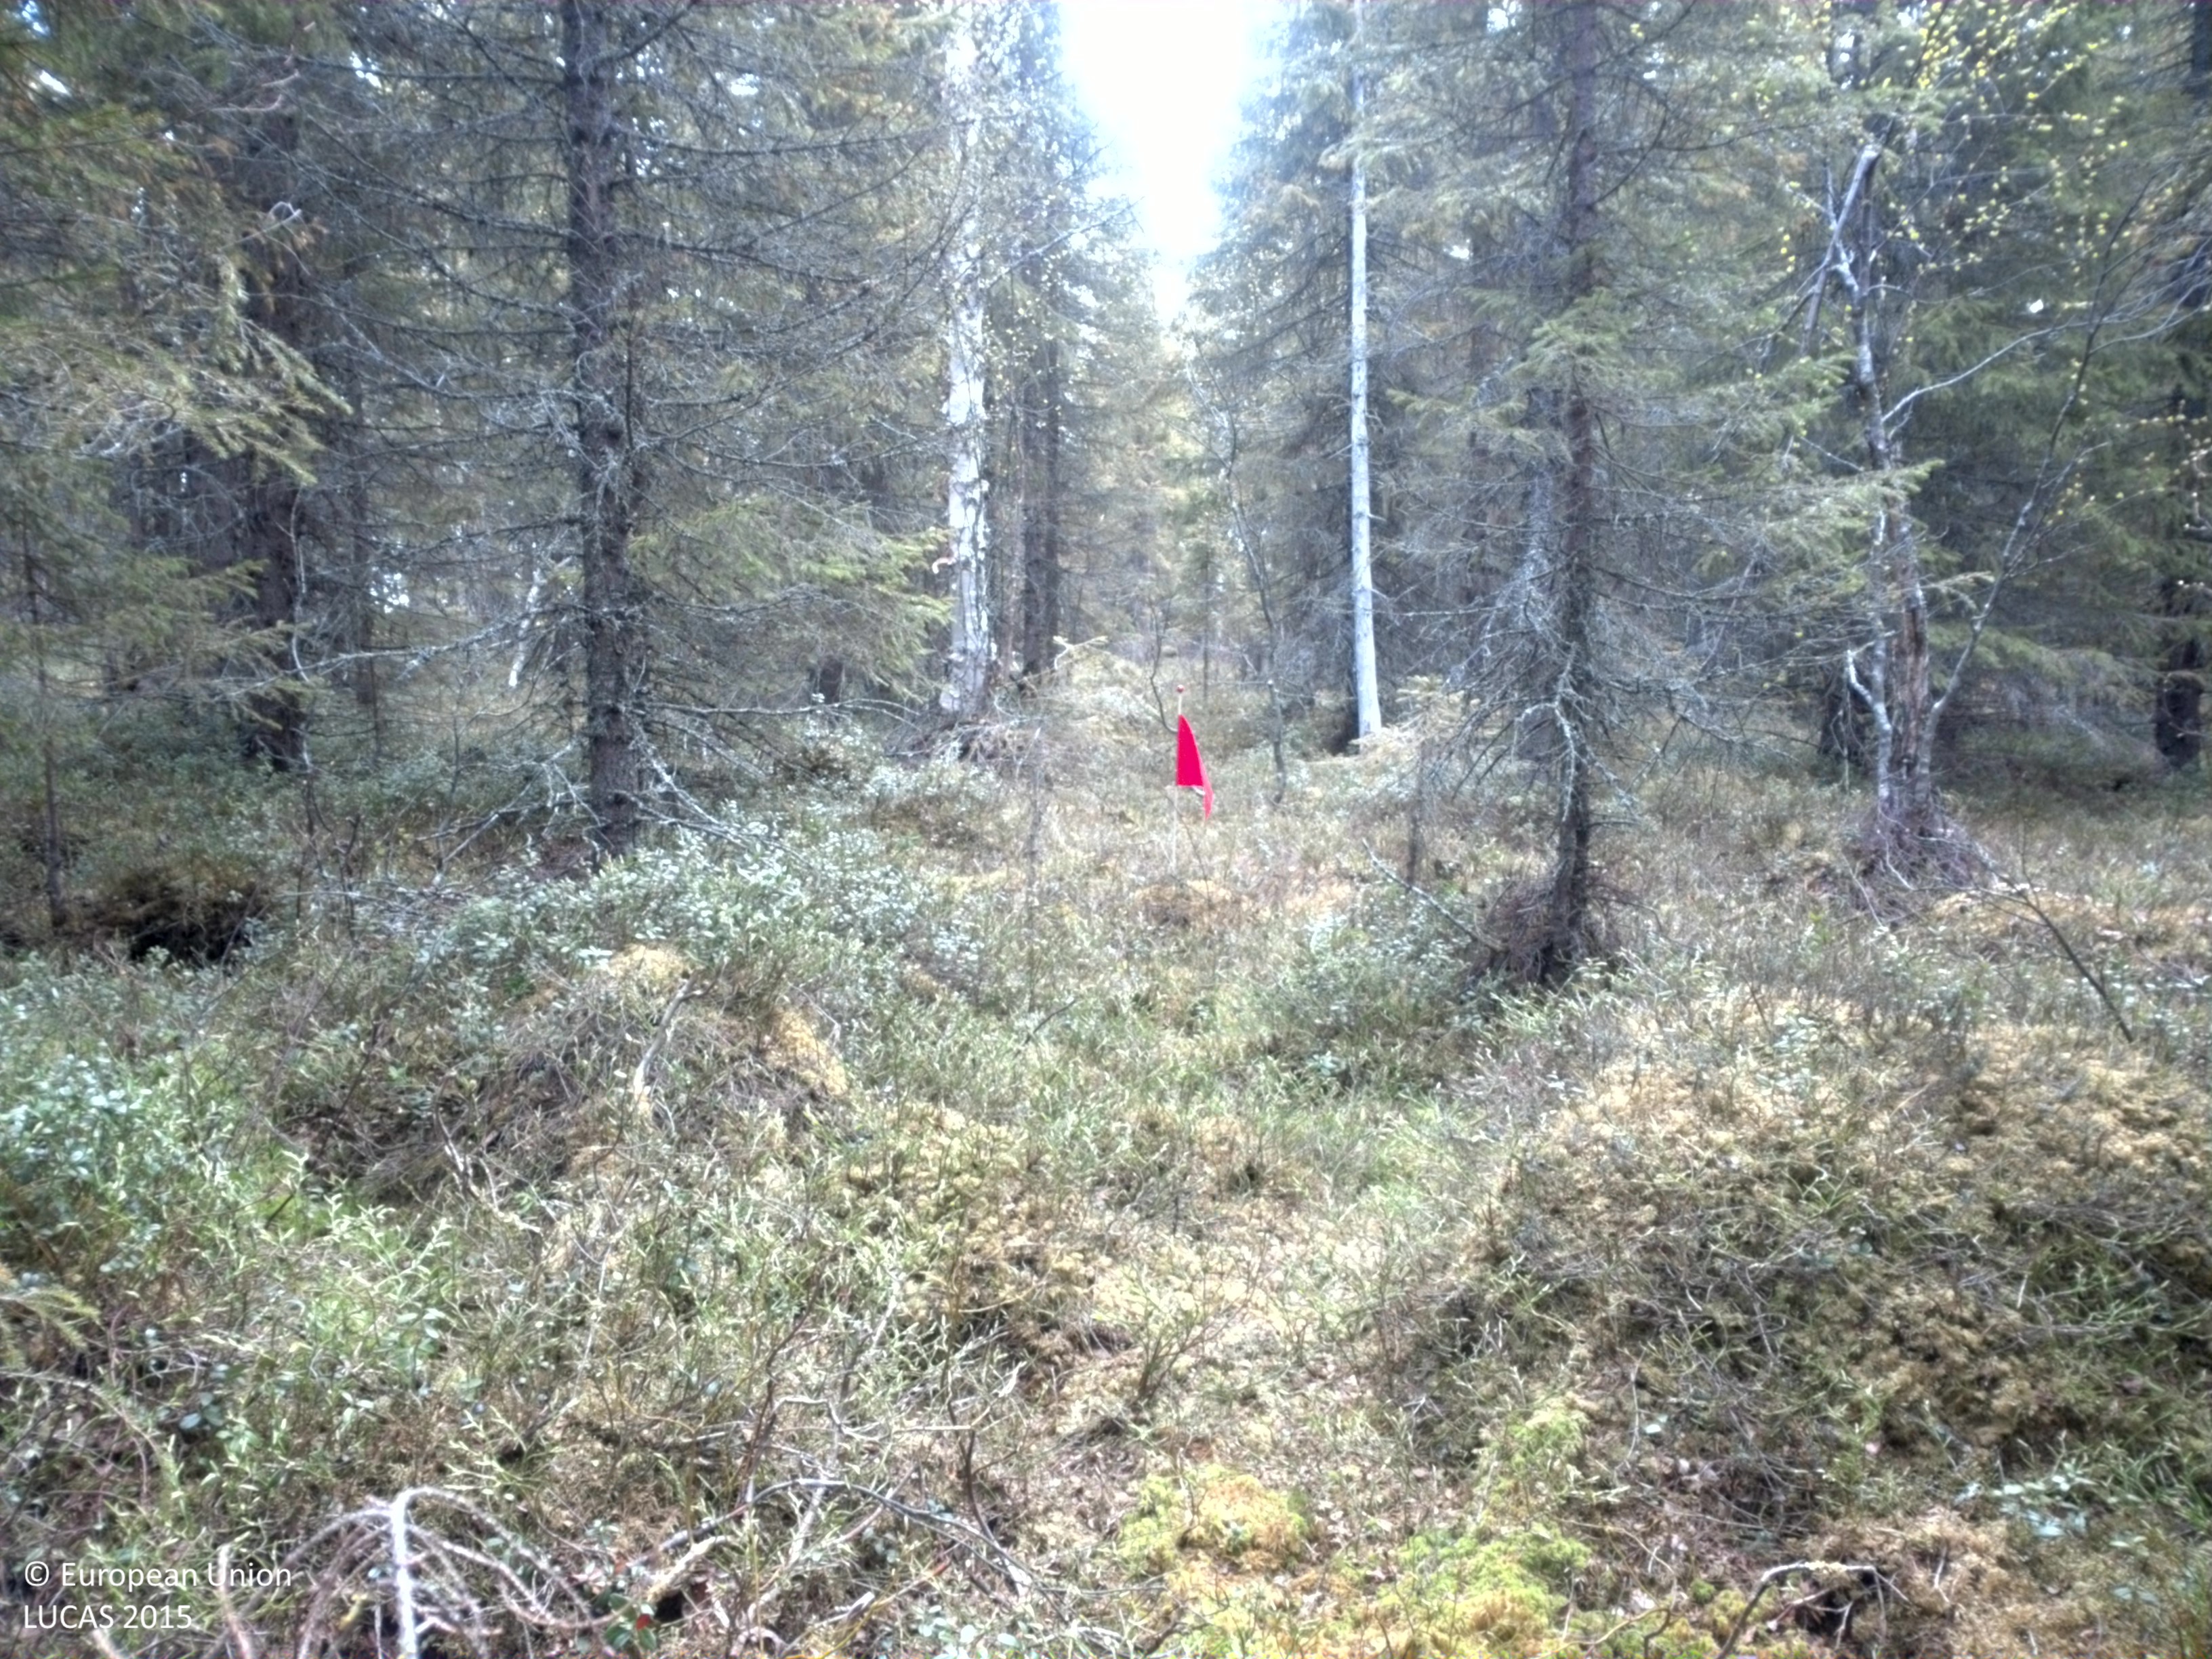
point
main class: Woodland
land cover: Spruce dominated coniferous woodland
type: boreal forest
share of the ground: 50 - 75 %
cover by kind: coniferous forest trees 55 %, herbaceous plants 20 %, lichens and mosses 15 %, broadleaved forest trees 5 %, shrubs 5 %
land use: Forestry
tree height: > 5 m
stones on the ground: < 10 %
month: June
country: SE
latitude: 64.3143
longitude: 18.1785
